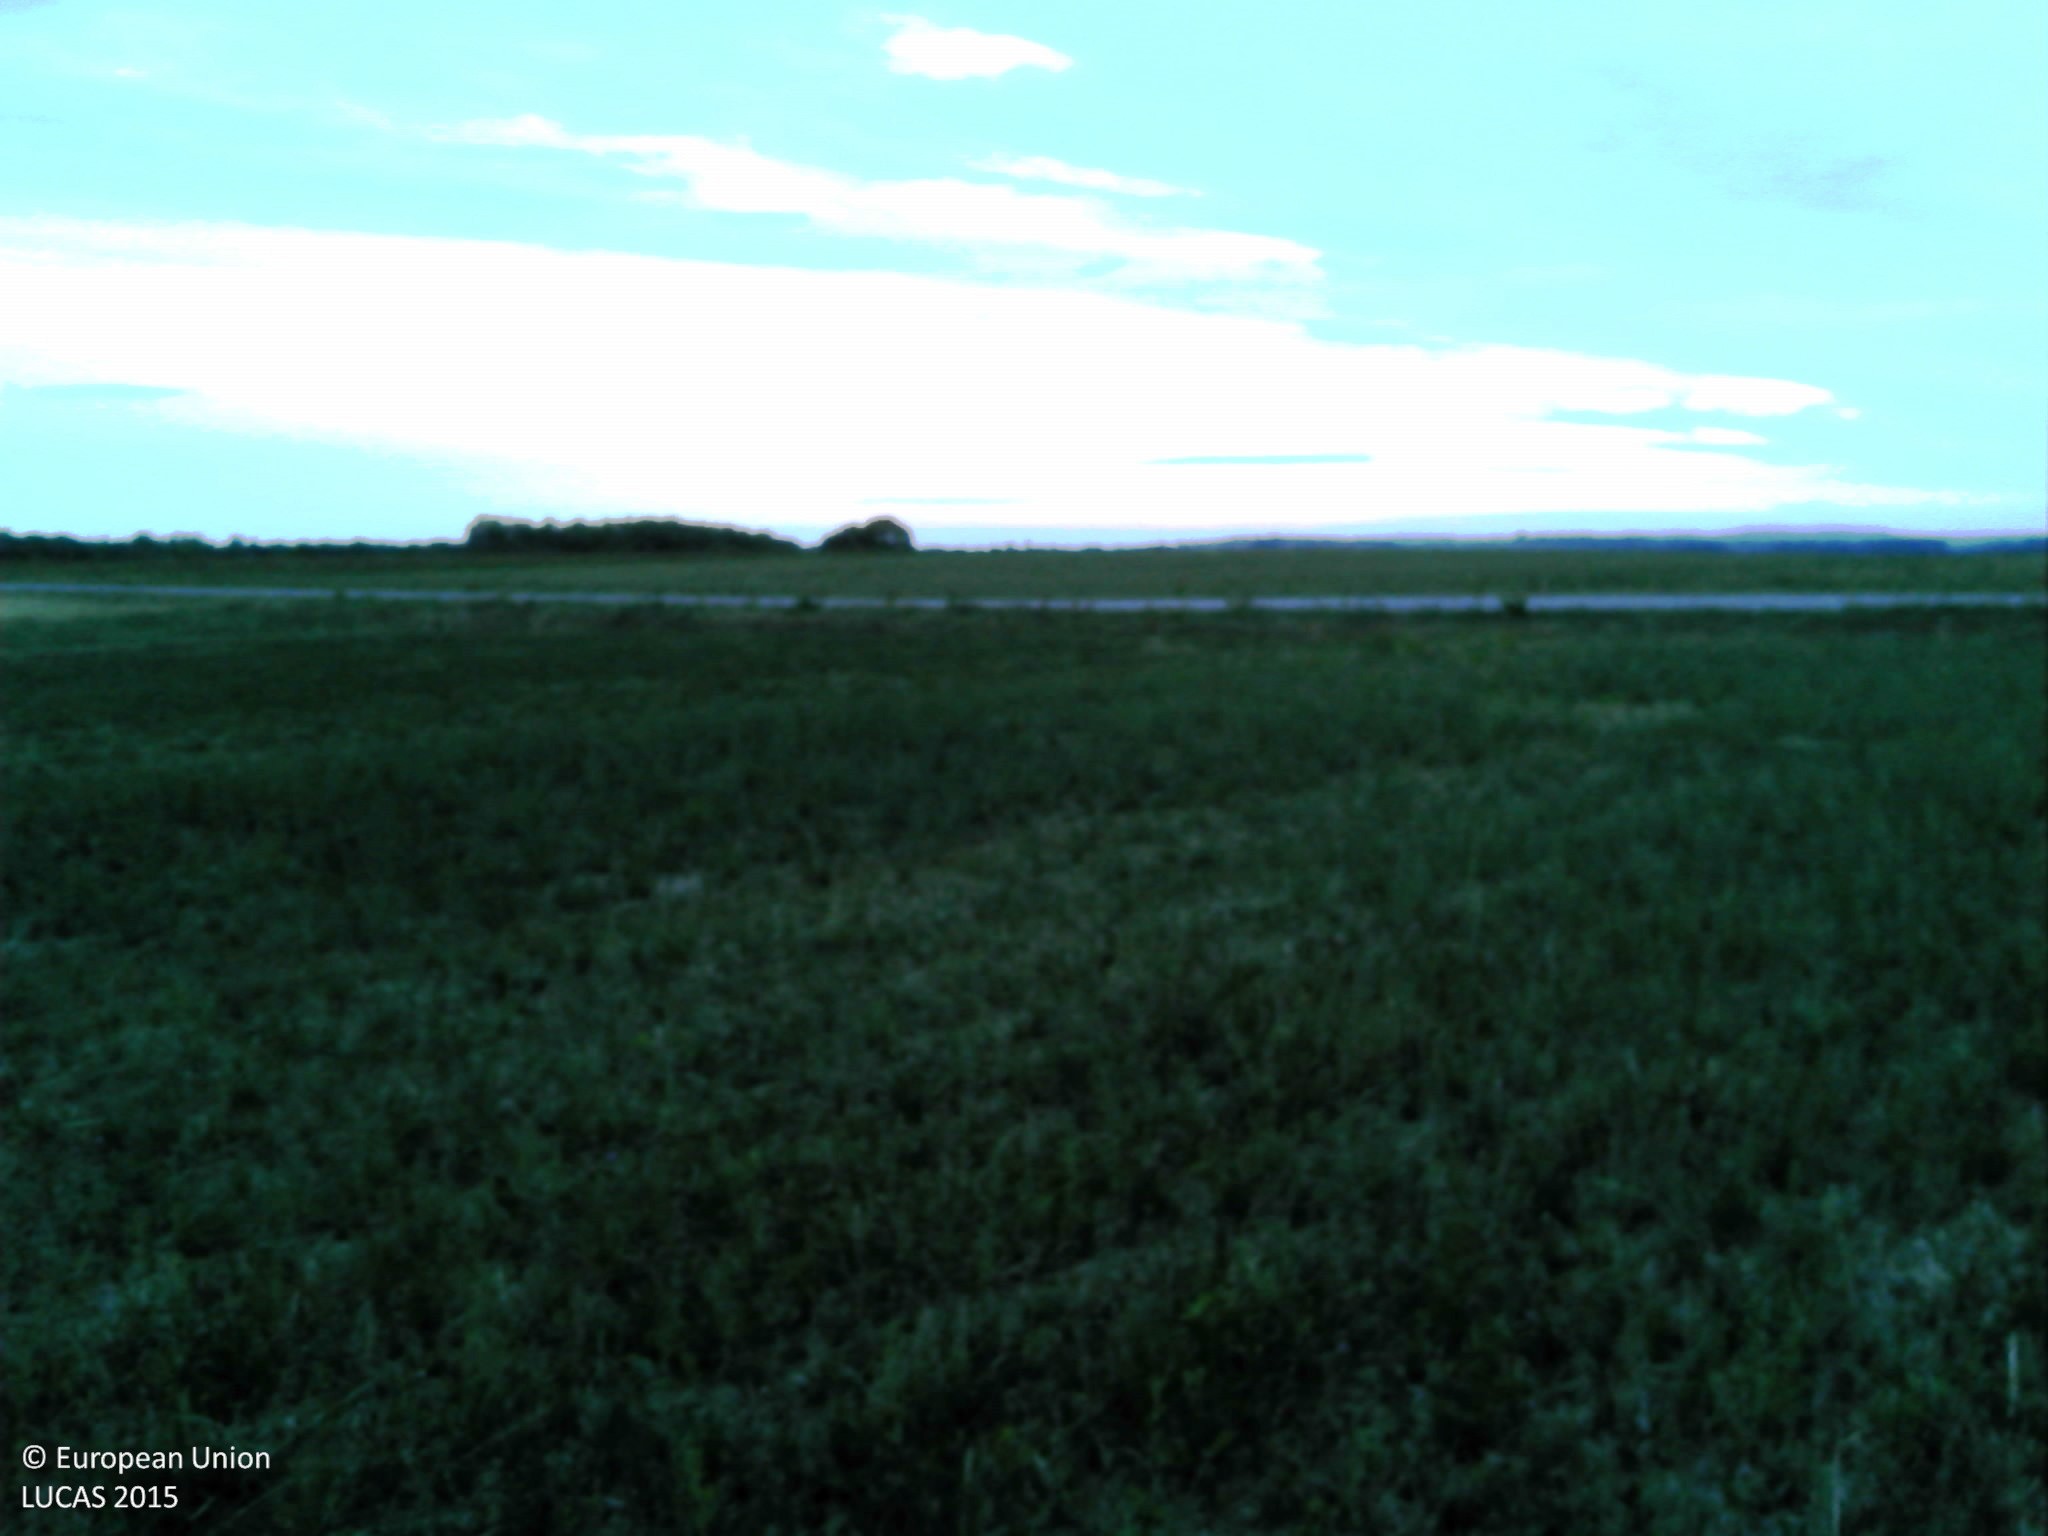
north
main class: Grassland
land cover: Grassland without tree/shrub cover
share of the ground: 50 - 75 %
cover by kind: herbaceous plants 100 %
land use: Agriculture (excluding fallow land and kitchen gardens)
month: August
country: FR
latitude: 48.1238
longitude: 6.2524
